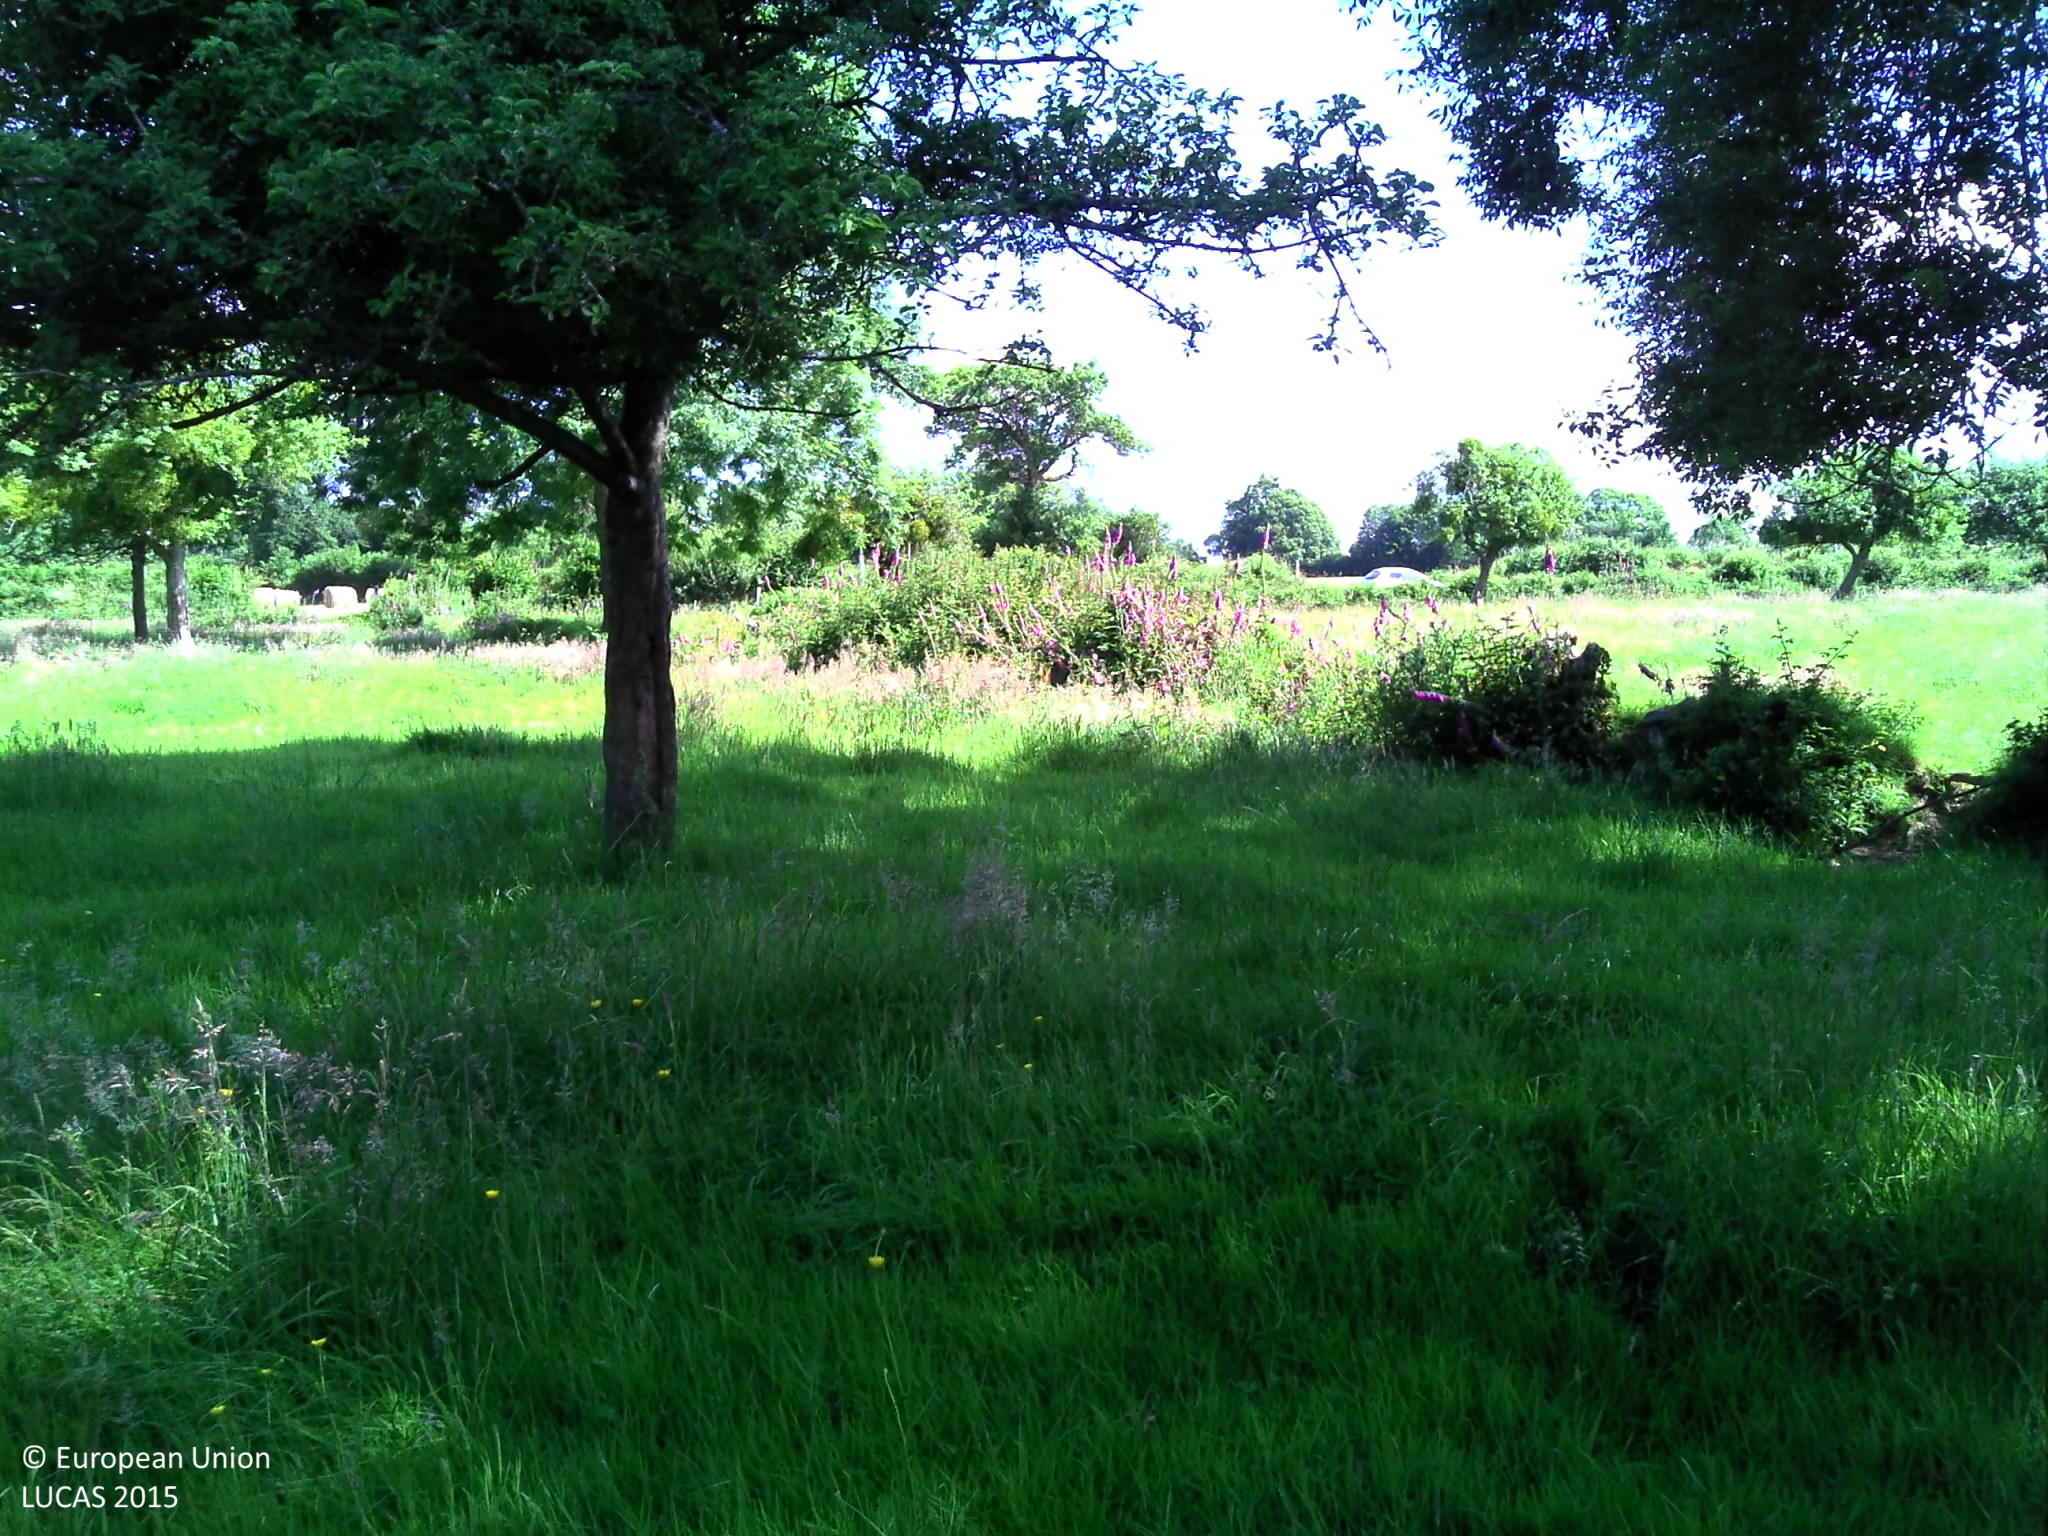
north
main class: Grassland
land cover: Grassland with sparse tree/shrub cover
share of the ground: > 75 %
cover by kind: herbaceous plants 95 %, broadleaved forest trees 5 %
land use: Agriculture (excluding fallow land and kitchen gardens)
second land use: Forestry
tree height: > 5 m
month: June
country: FR
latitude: 49.0921
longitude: -1.3165
